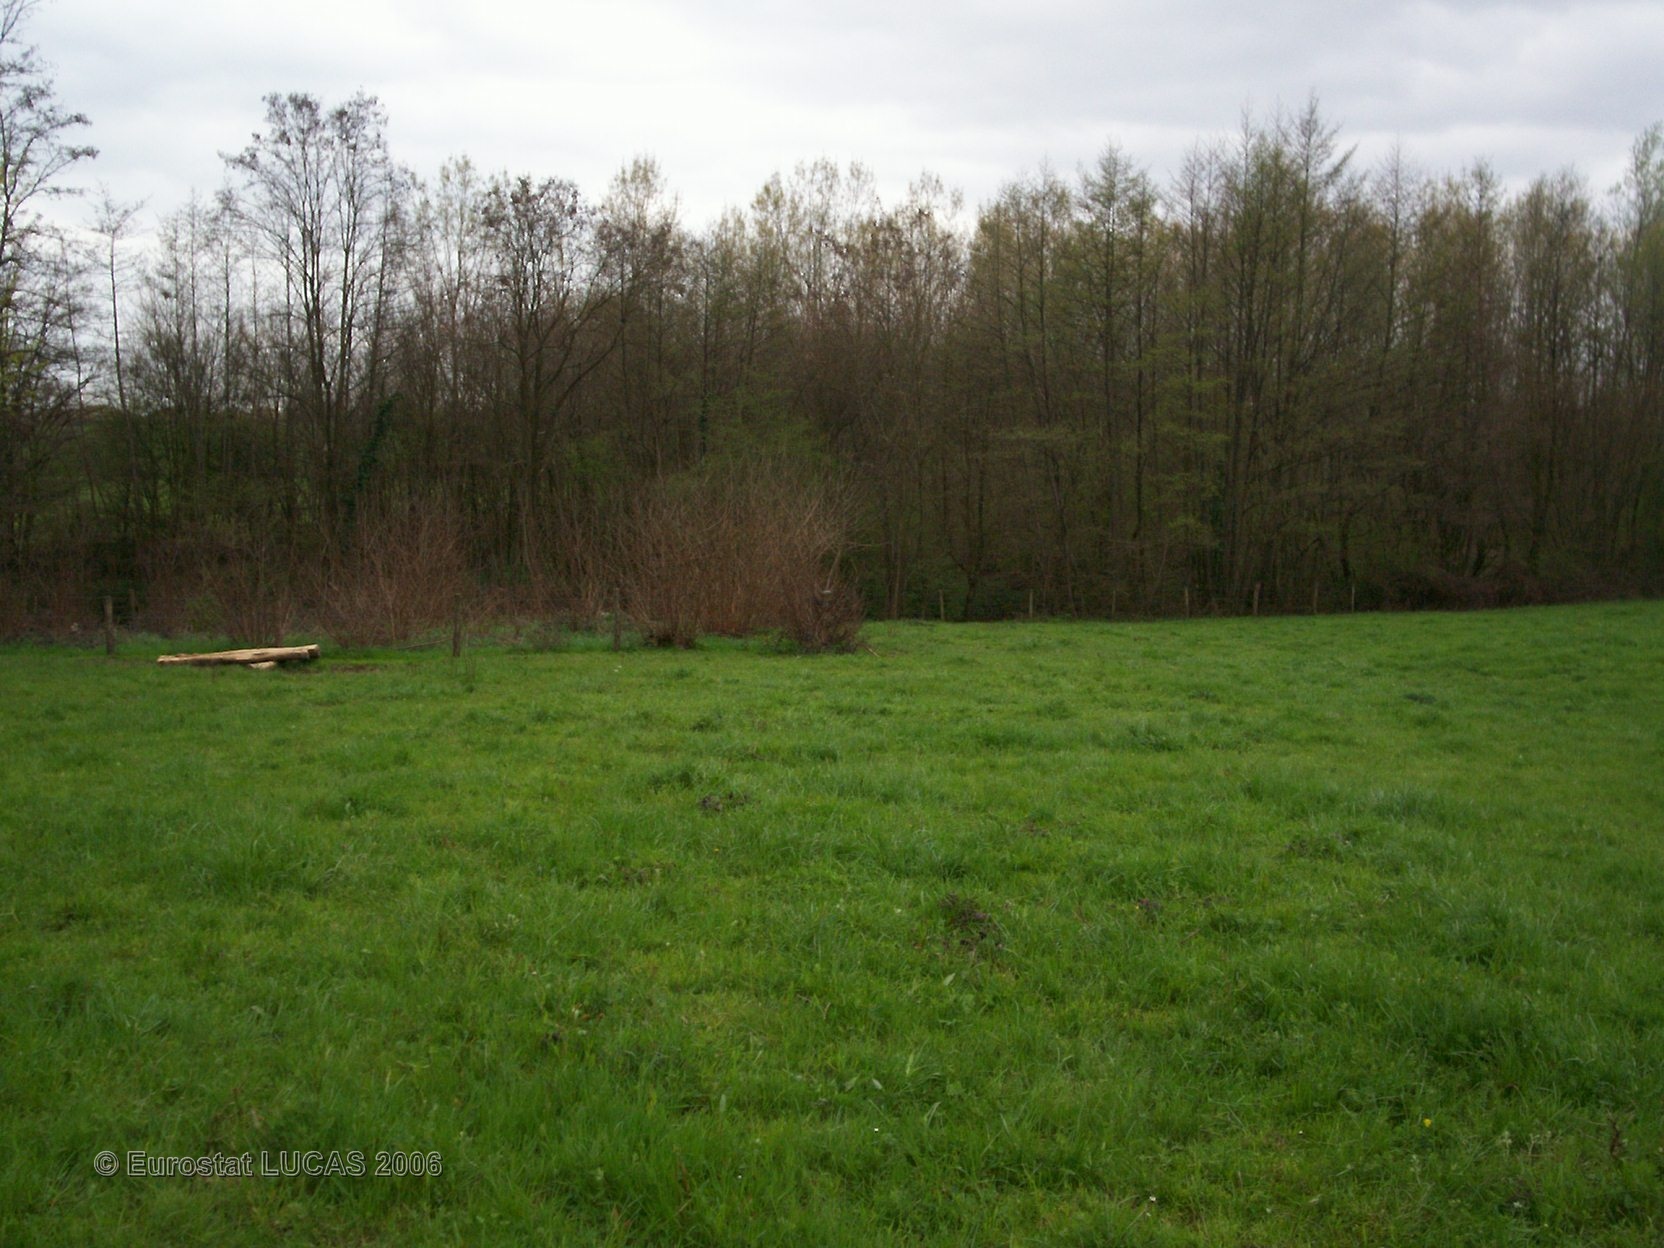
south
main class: Grassland
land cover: Grassland without tree/shrub cover
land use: Agriculture (excluding fallow land and kitchen gardens)
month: April
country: FR
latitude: 46.2416
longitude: 4.7759
